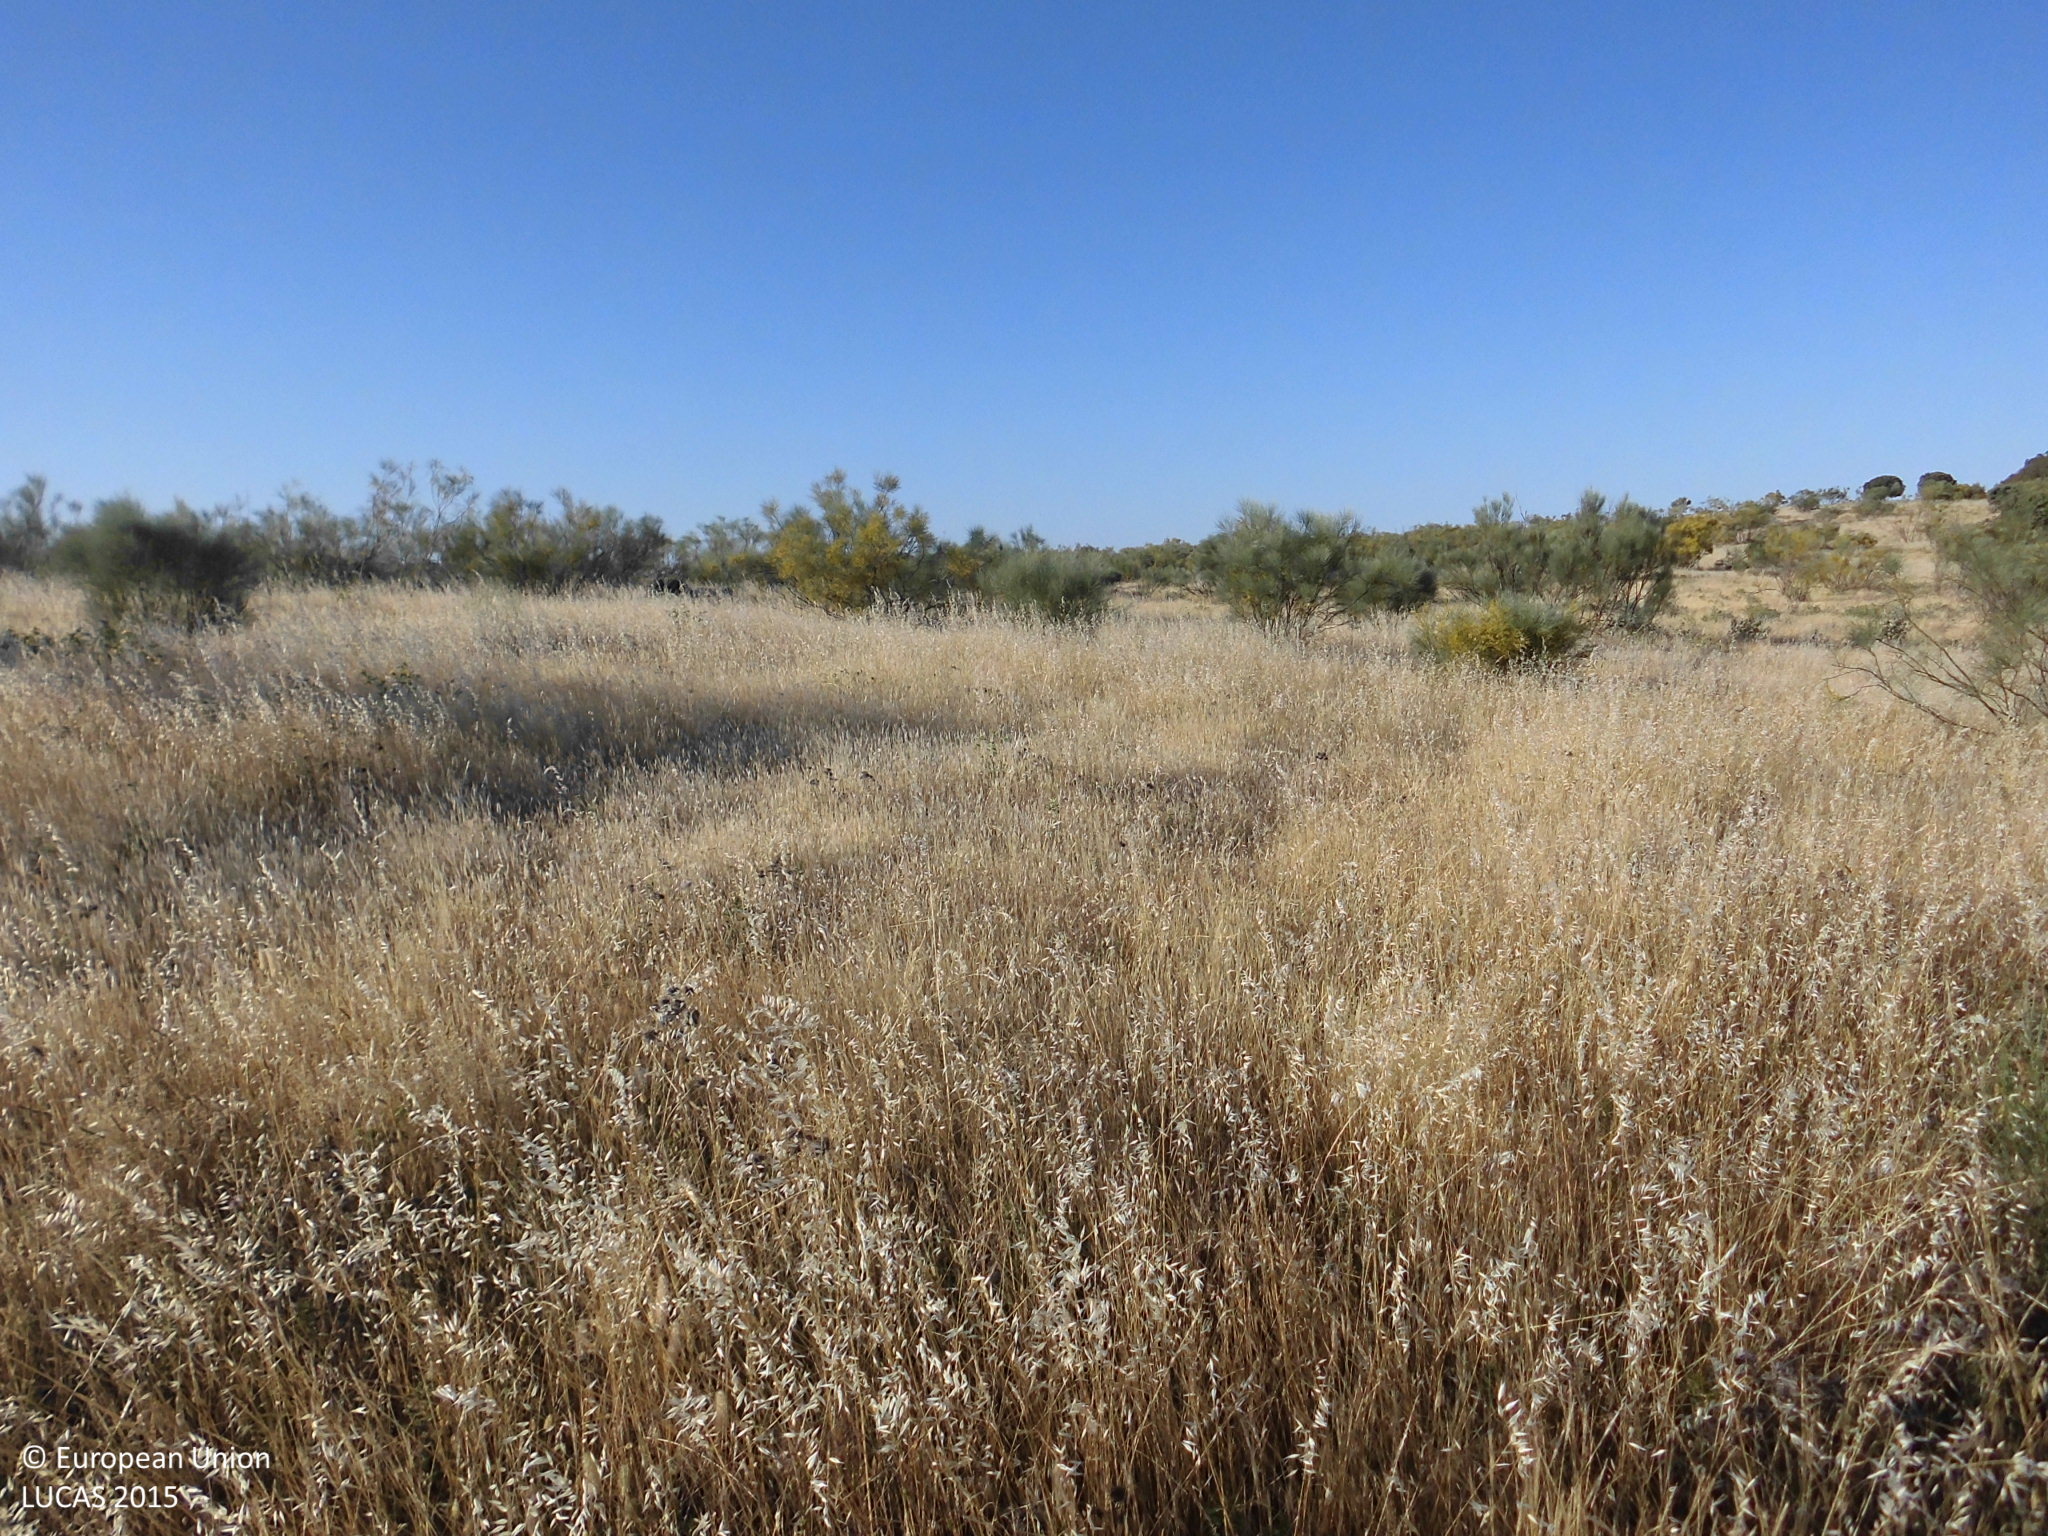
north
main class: Shrubland
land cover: Shrubland without tree cover
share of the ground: 10 - 25 %
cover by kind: herbaceous plants 90 %, shrubs 10 %
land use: Agriculture (excluding fallow land and kitchen gardens)
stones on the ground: 10 - 25 %
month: May
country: ES
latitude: 39.5391
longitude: -5.9668
